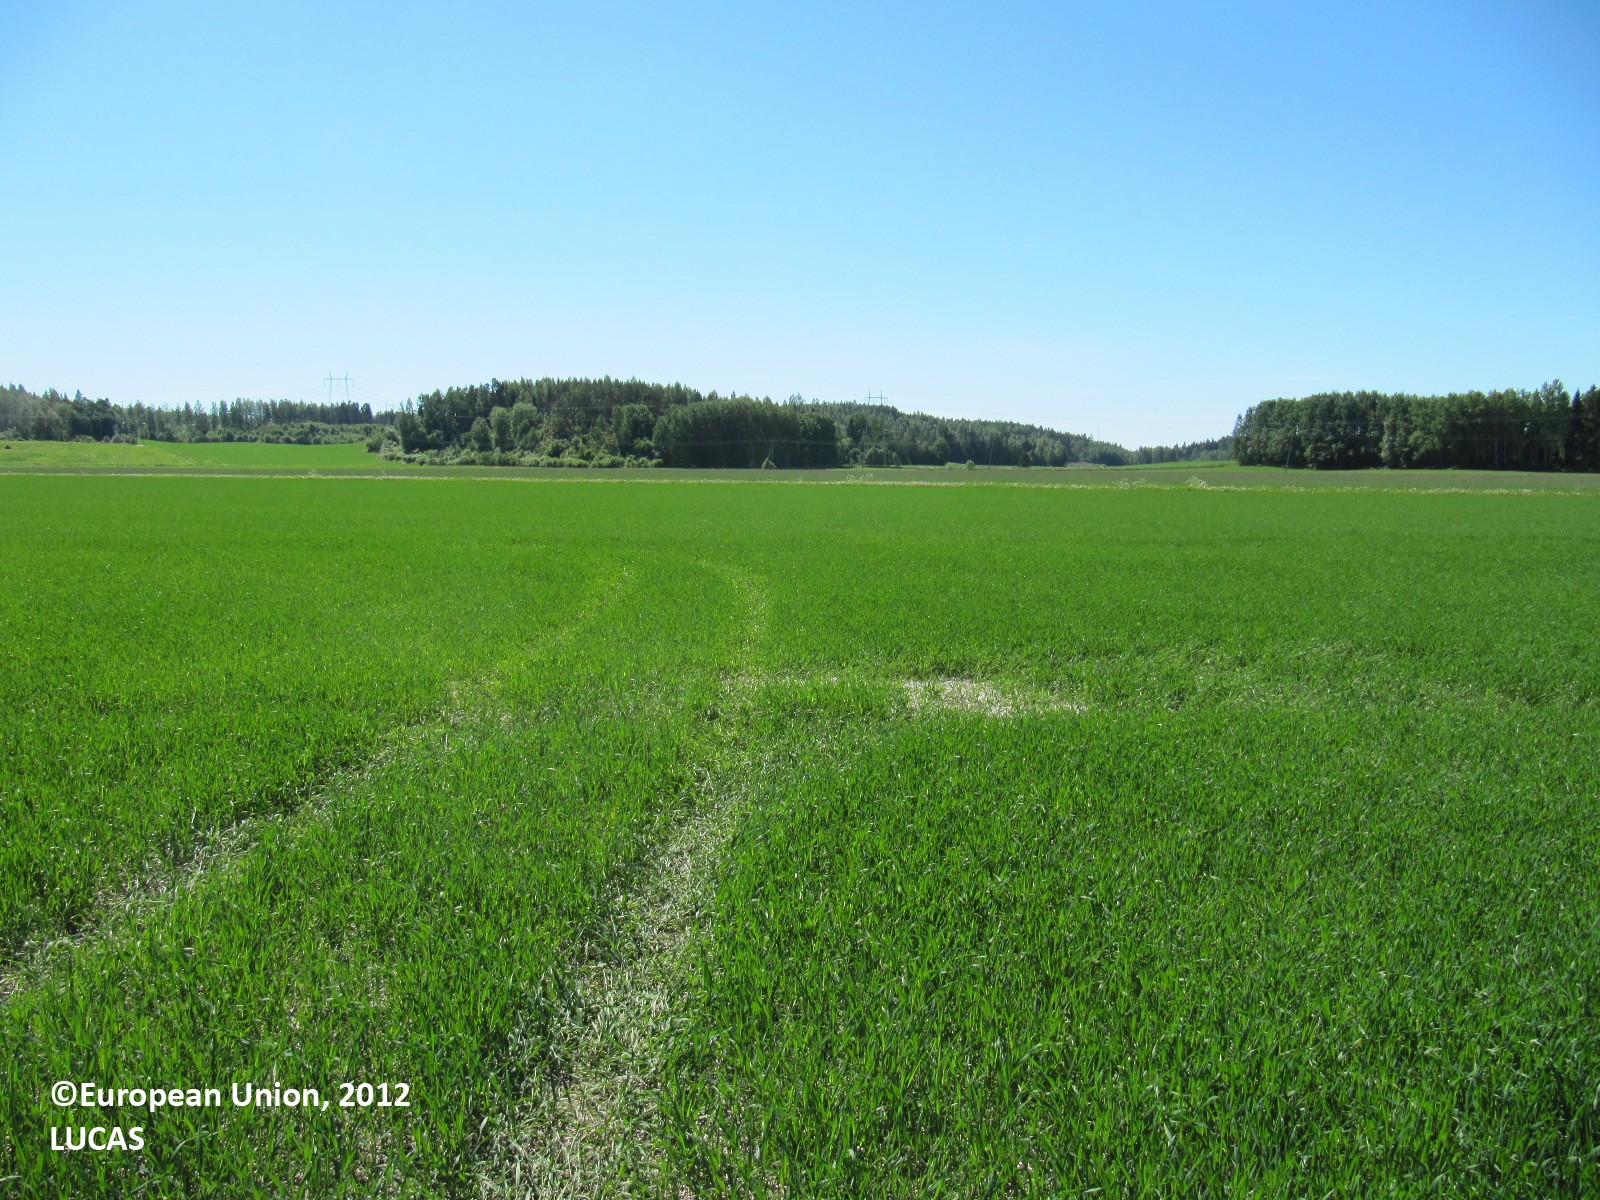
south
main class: Cropland
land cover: Common wheat
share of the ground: > 75 %
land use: Agriculture (excluding fallow land and kitchen gardens)
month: June
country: FI
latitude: 60.1144
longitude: 24.2273
